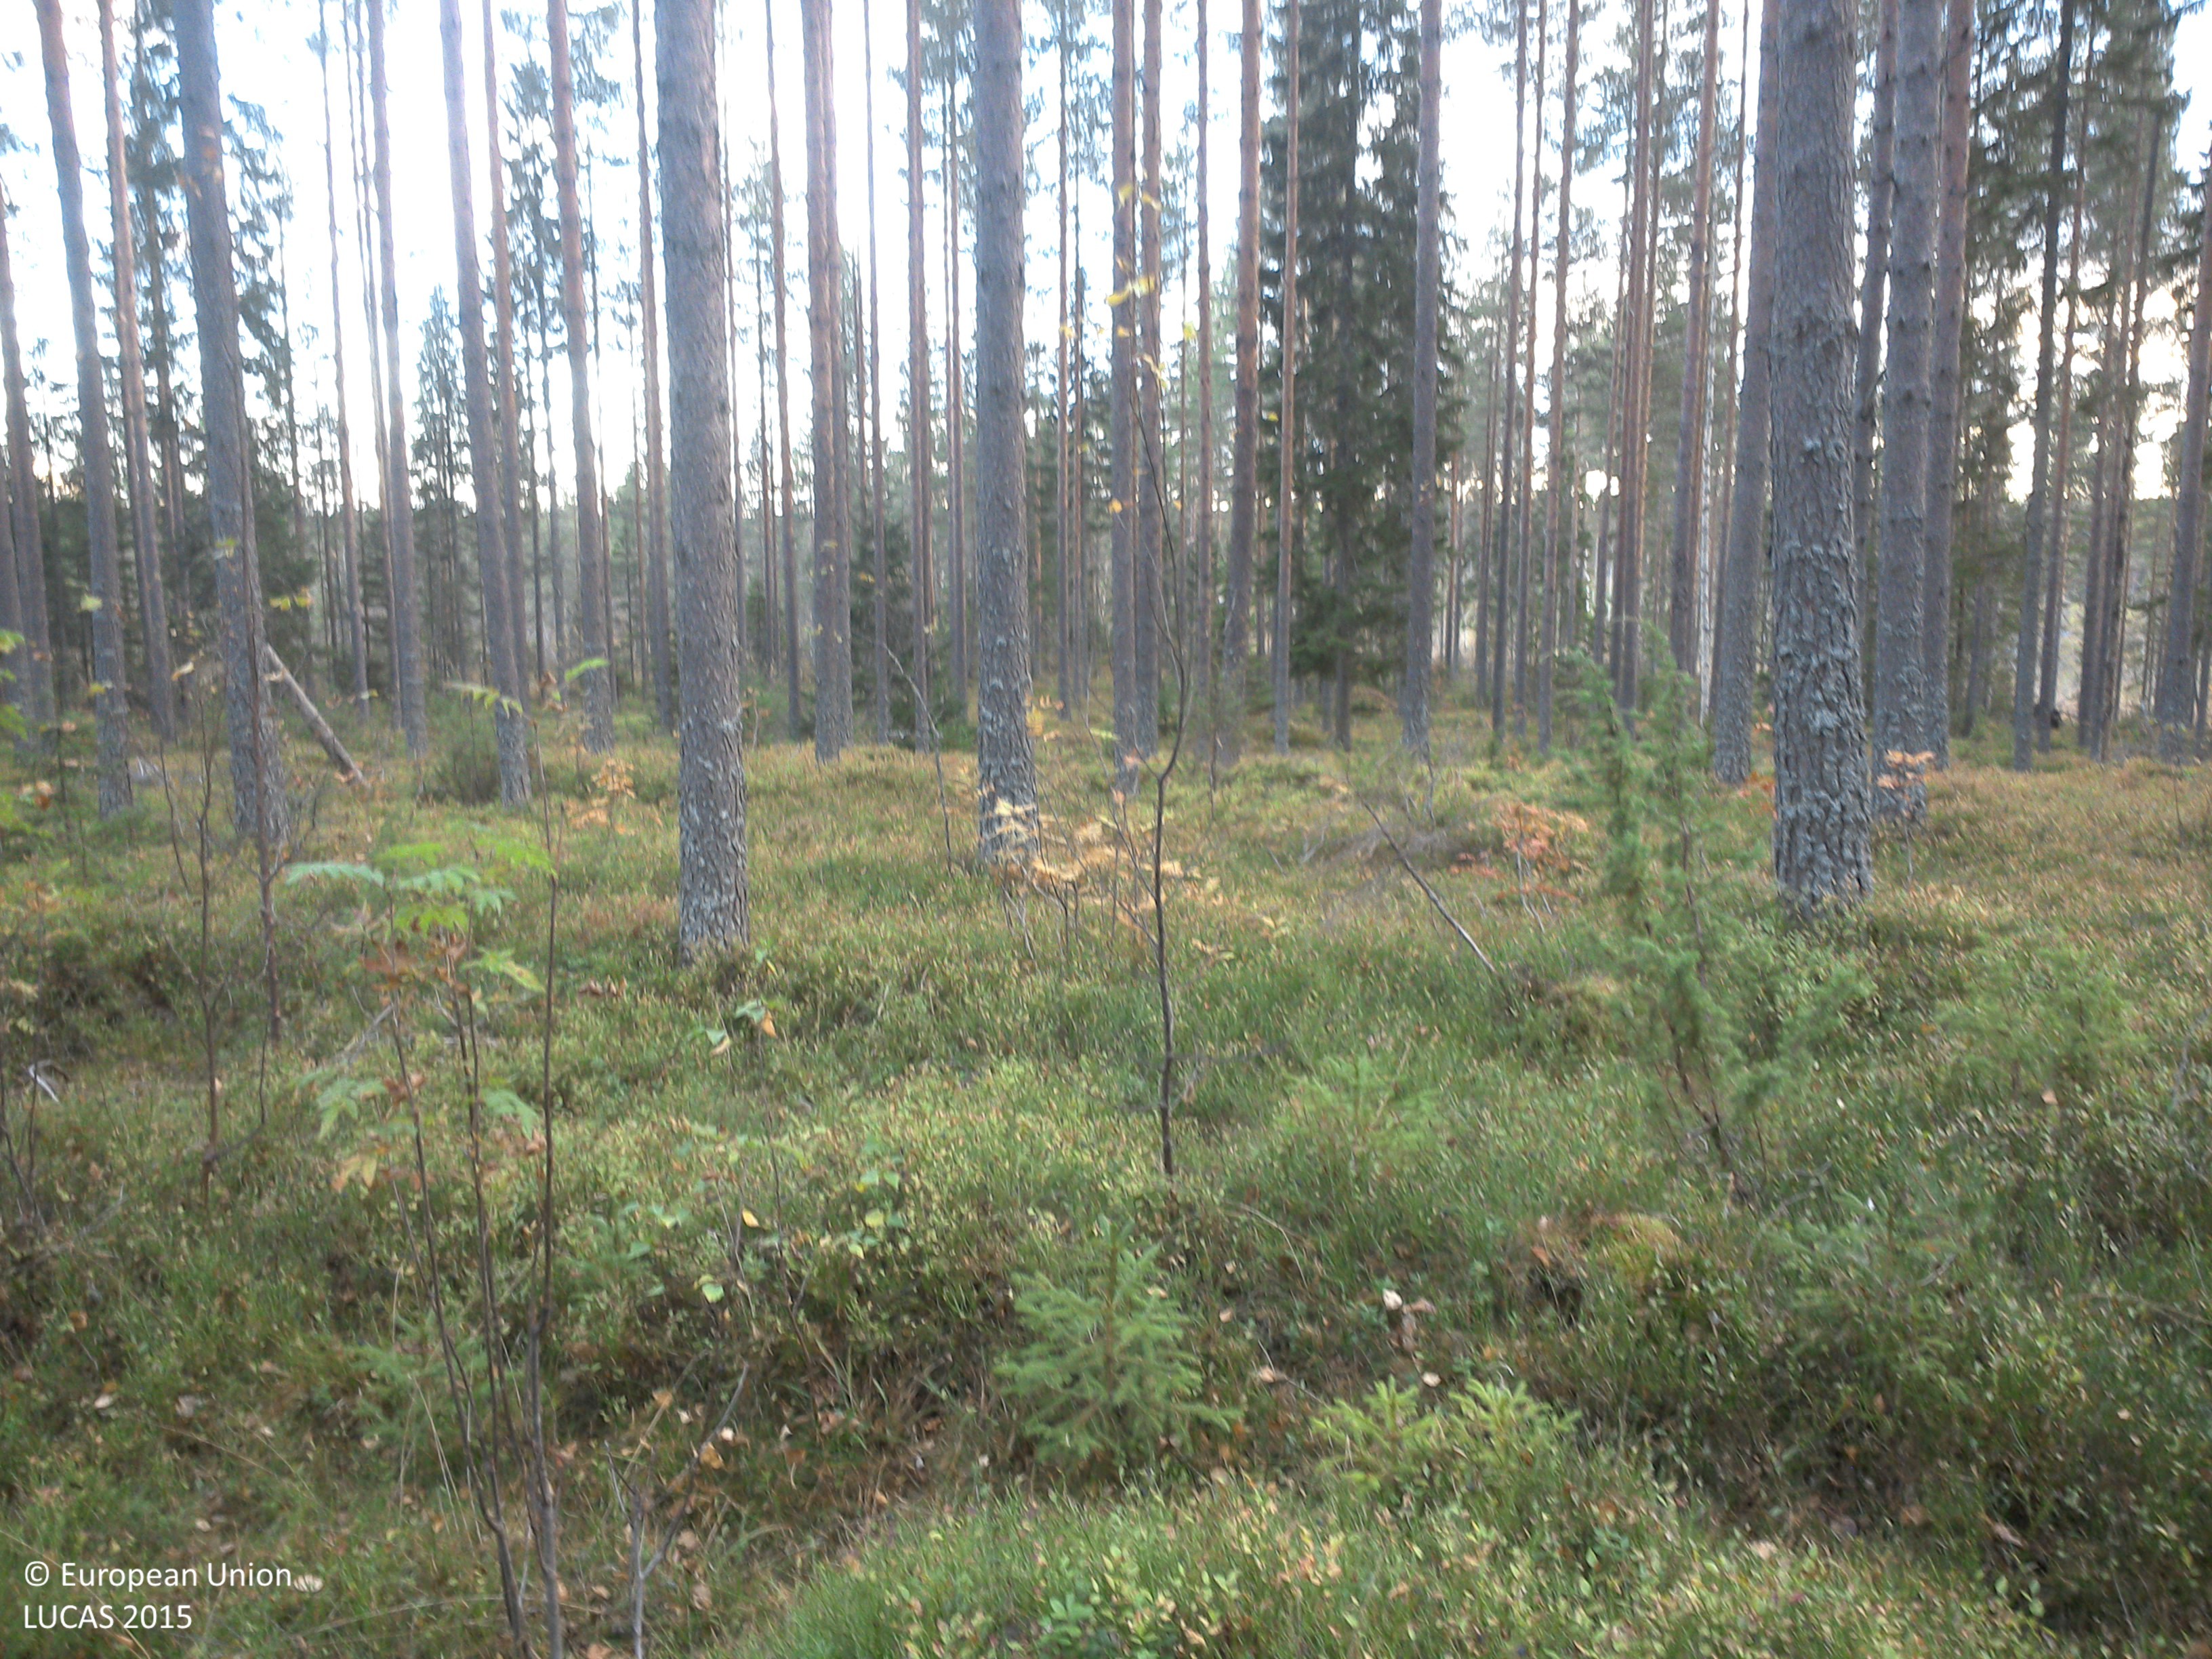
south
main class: Woodland
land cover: Pine dominated mixed woodland
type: boreal forest
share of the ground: 25 - 50 %
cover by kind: shrubs 50 %, coniferous forest trees 30 %, broadleaved forest trees 20 %
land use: Forestry
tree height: > 5 m
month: October
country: SE
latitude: 63.8676
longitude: 19.9304
